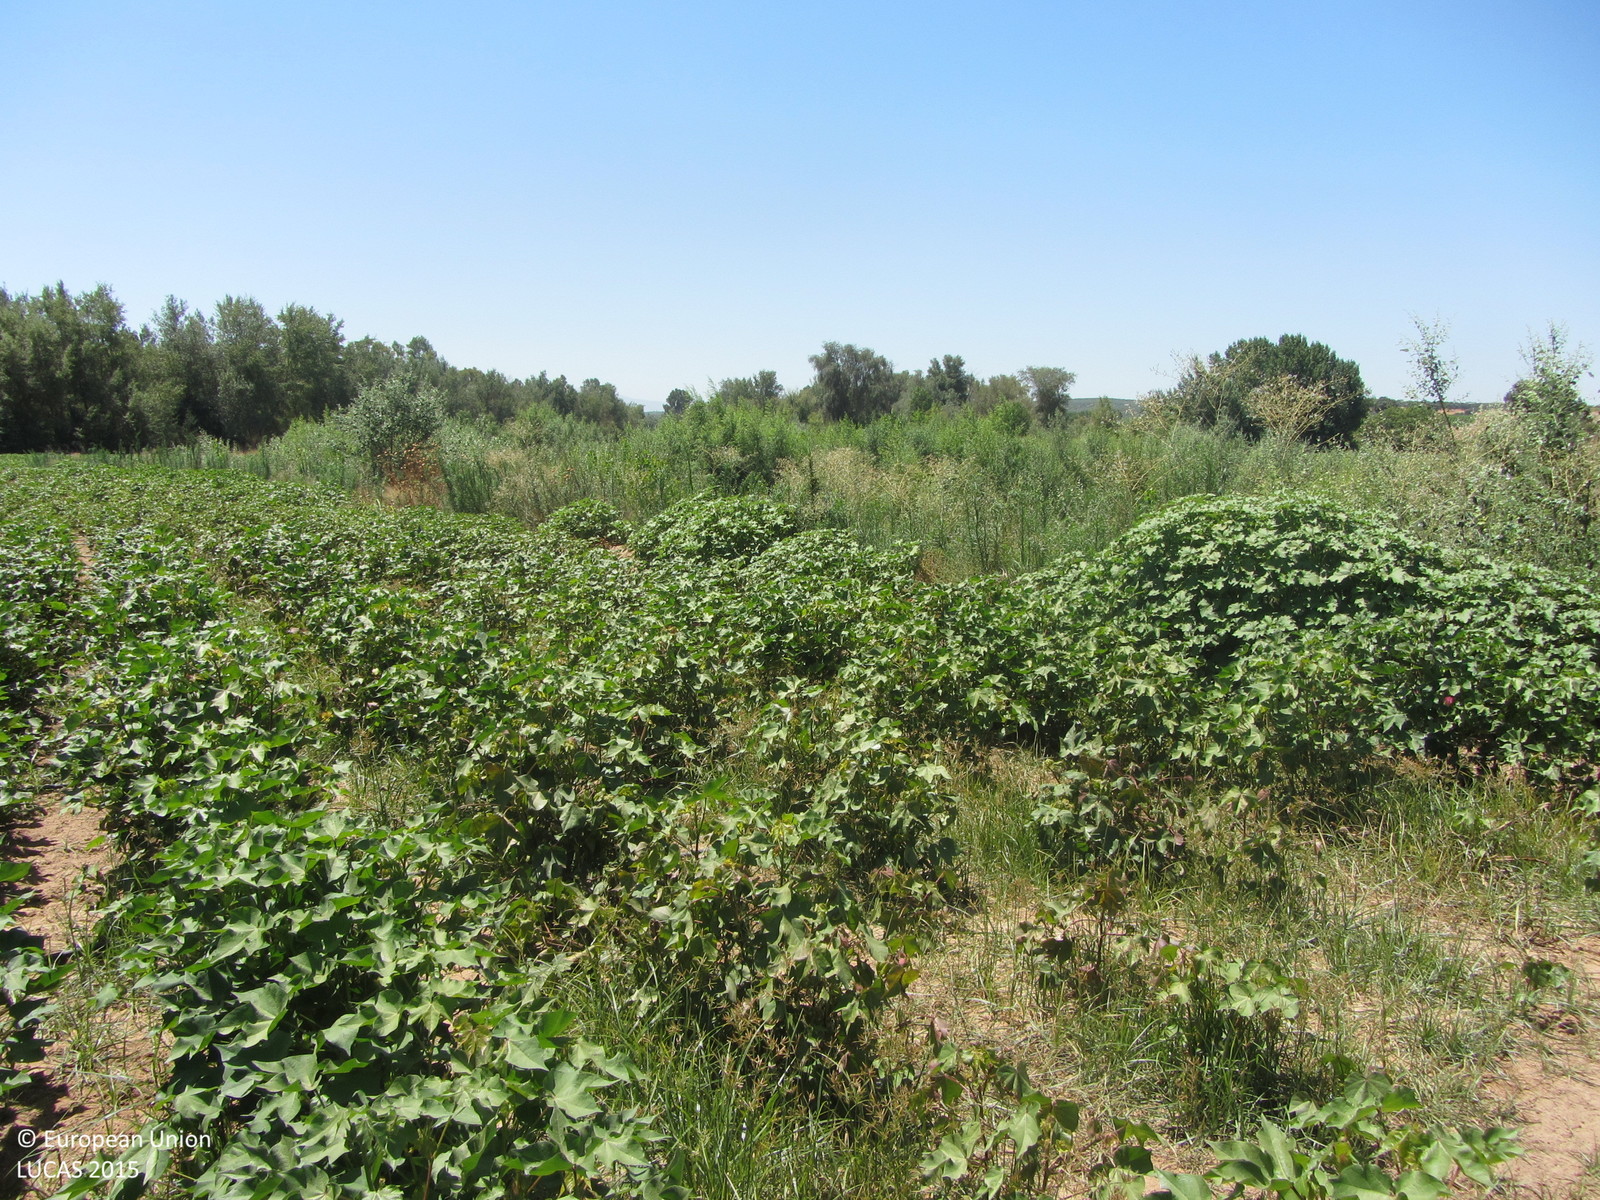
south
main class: Cropland
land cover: Cotton
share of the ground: > 75 %
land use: Agriculture (excluding fallow land and kitchen gardens)
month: July
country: ES
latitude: 38.0183
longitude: -3.8218
